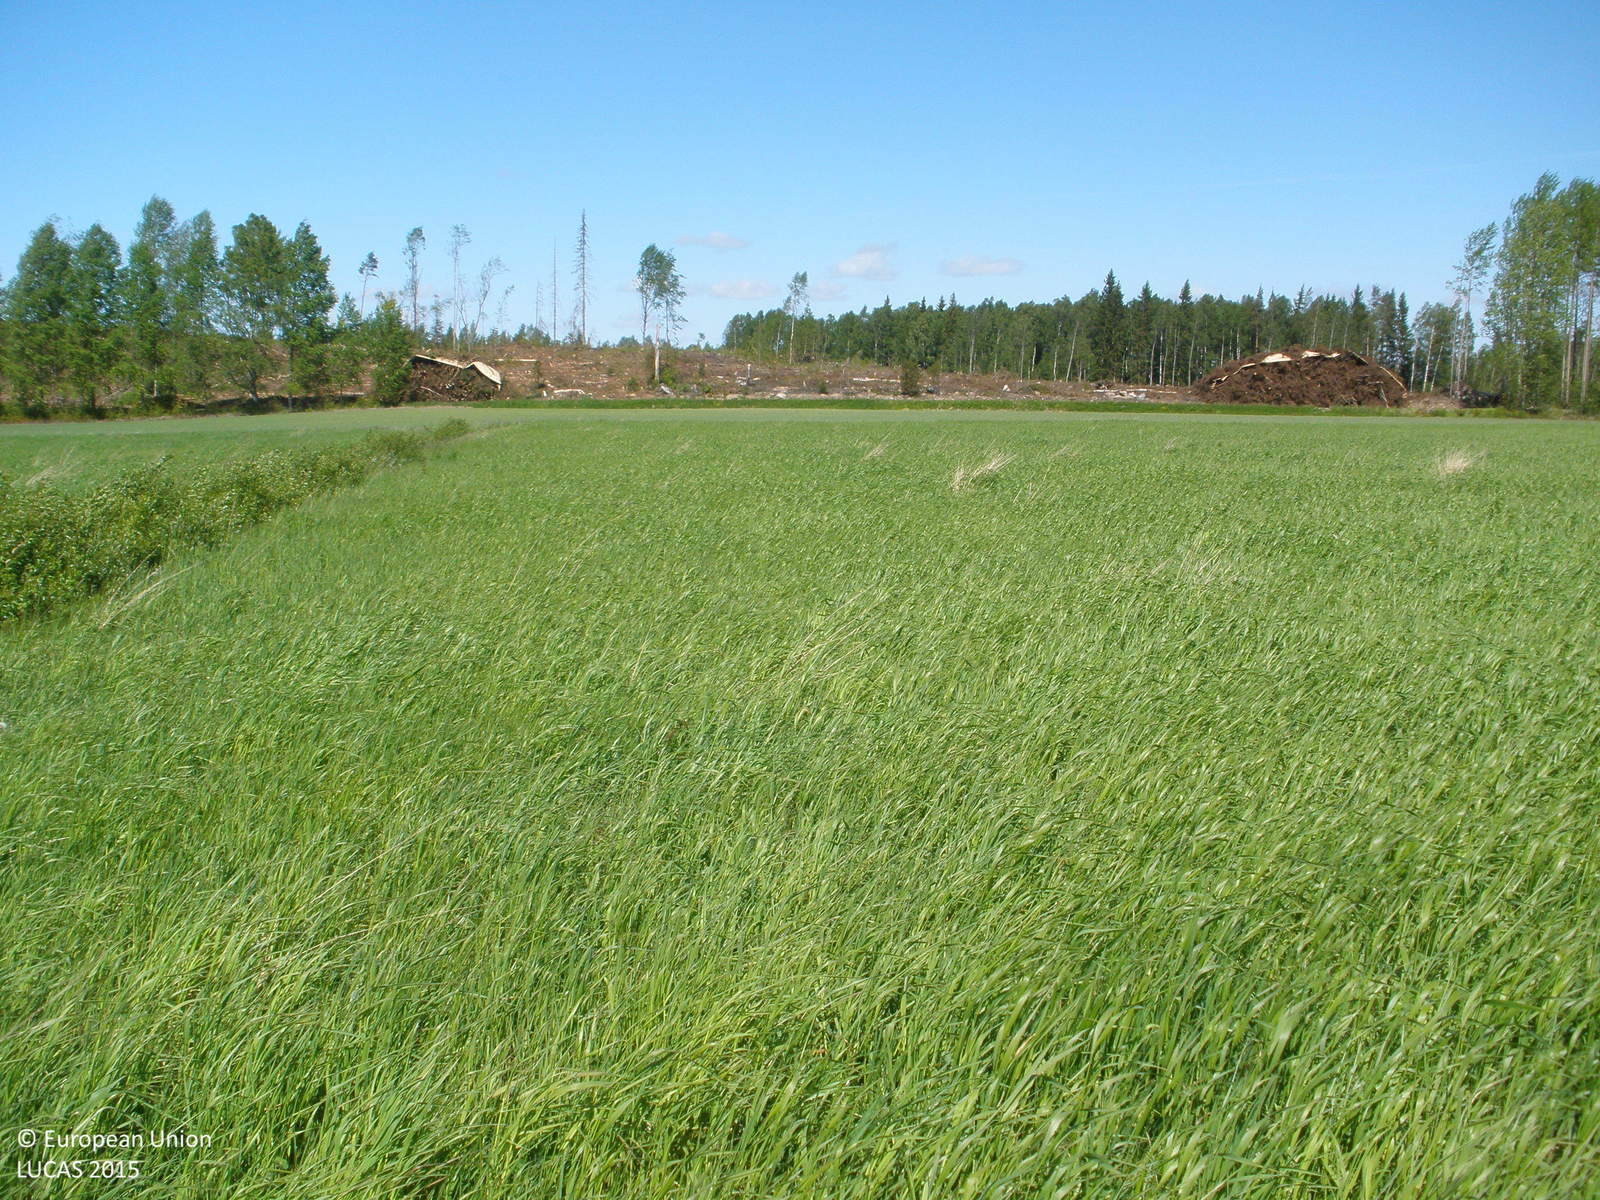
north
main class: Cropland
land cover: Temporary grasslands
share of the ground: > 75 %
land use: Agriculture (excluding fallow land and kitchen gardens)
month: June
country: FI
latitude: 60.7300
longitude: 23.5628
